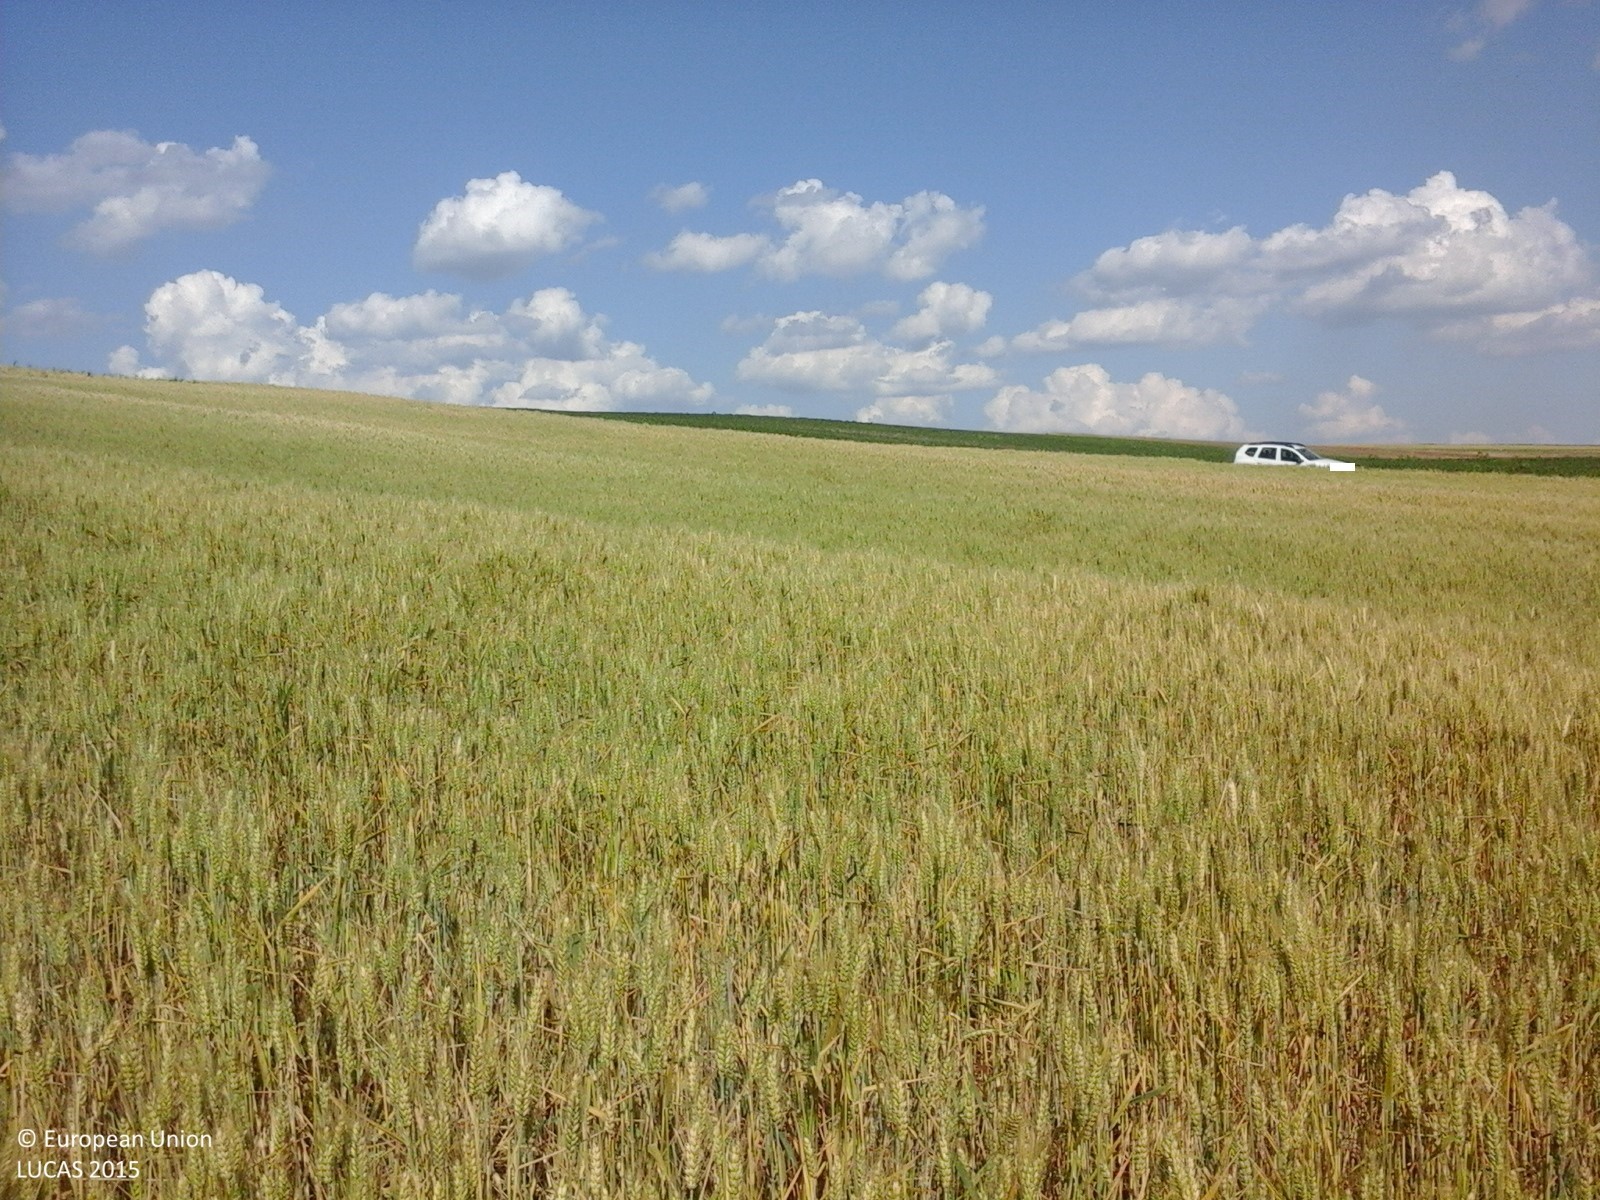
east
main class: Cropland
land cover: Common wheat
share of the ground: > 75 %
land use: Agriculture (excluding fallow land and kitchen gardens)
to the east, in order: Common wheat; Soya; Grassland without tree/shrub cover
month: June
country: RO
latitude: 47.9863
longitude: 26.8094
